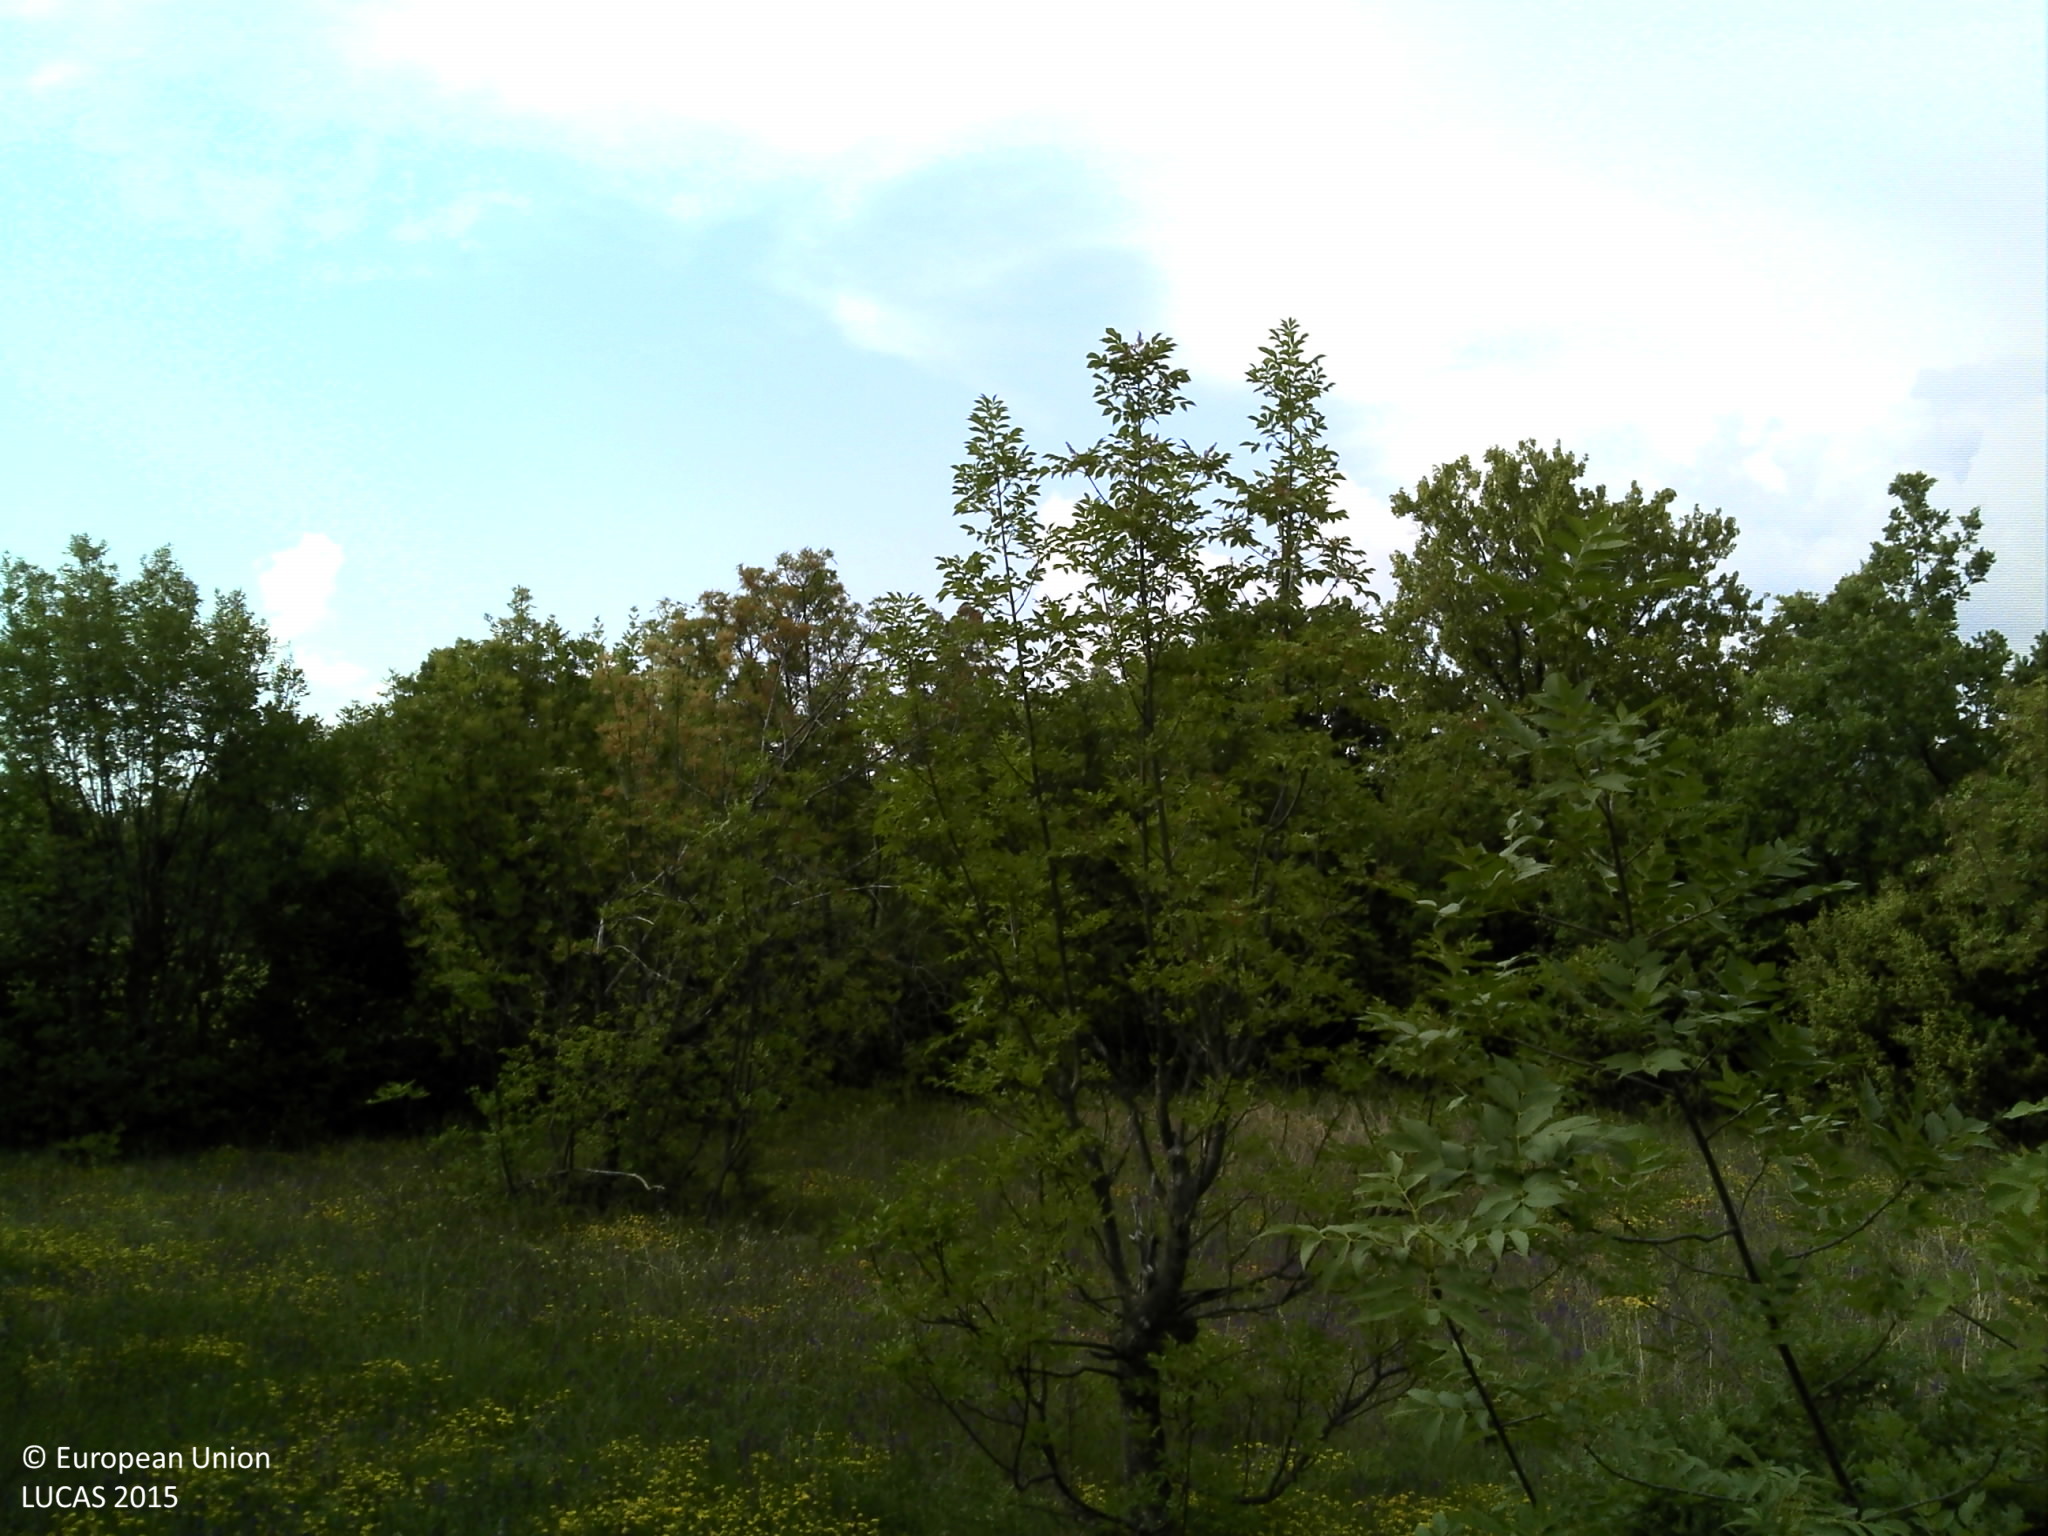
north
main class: Woodland
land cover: Broadleaved woodland
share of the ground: 25 - 50 %
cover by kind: shrubs 40 %, herbaceous plants 30 %, broadleaved forest trees 25 %, coniferous forest trees 5 %
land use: Semi-natural and natural areas not in use
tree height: < 5 m
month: May
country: HR
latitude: 44.0164
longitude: 16.2671
